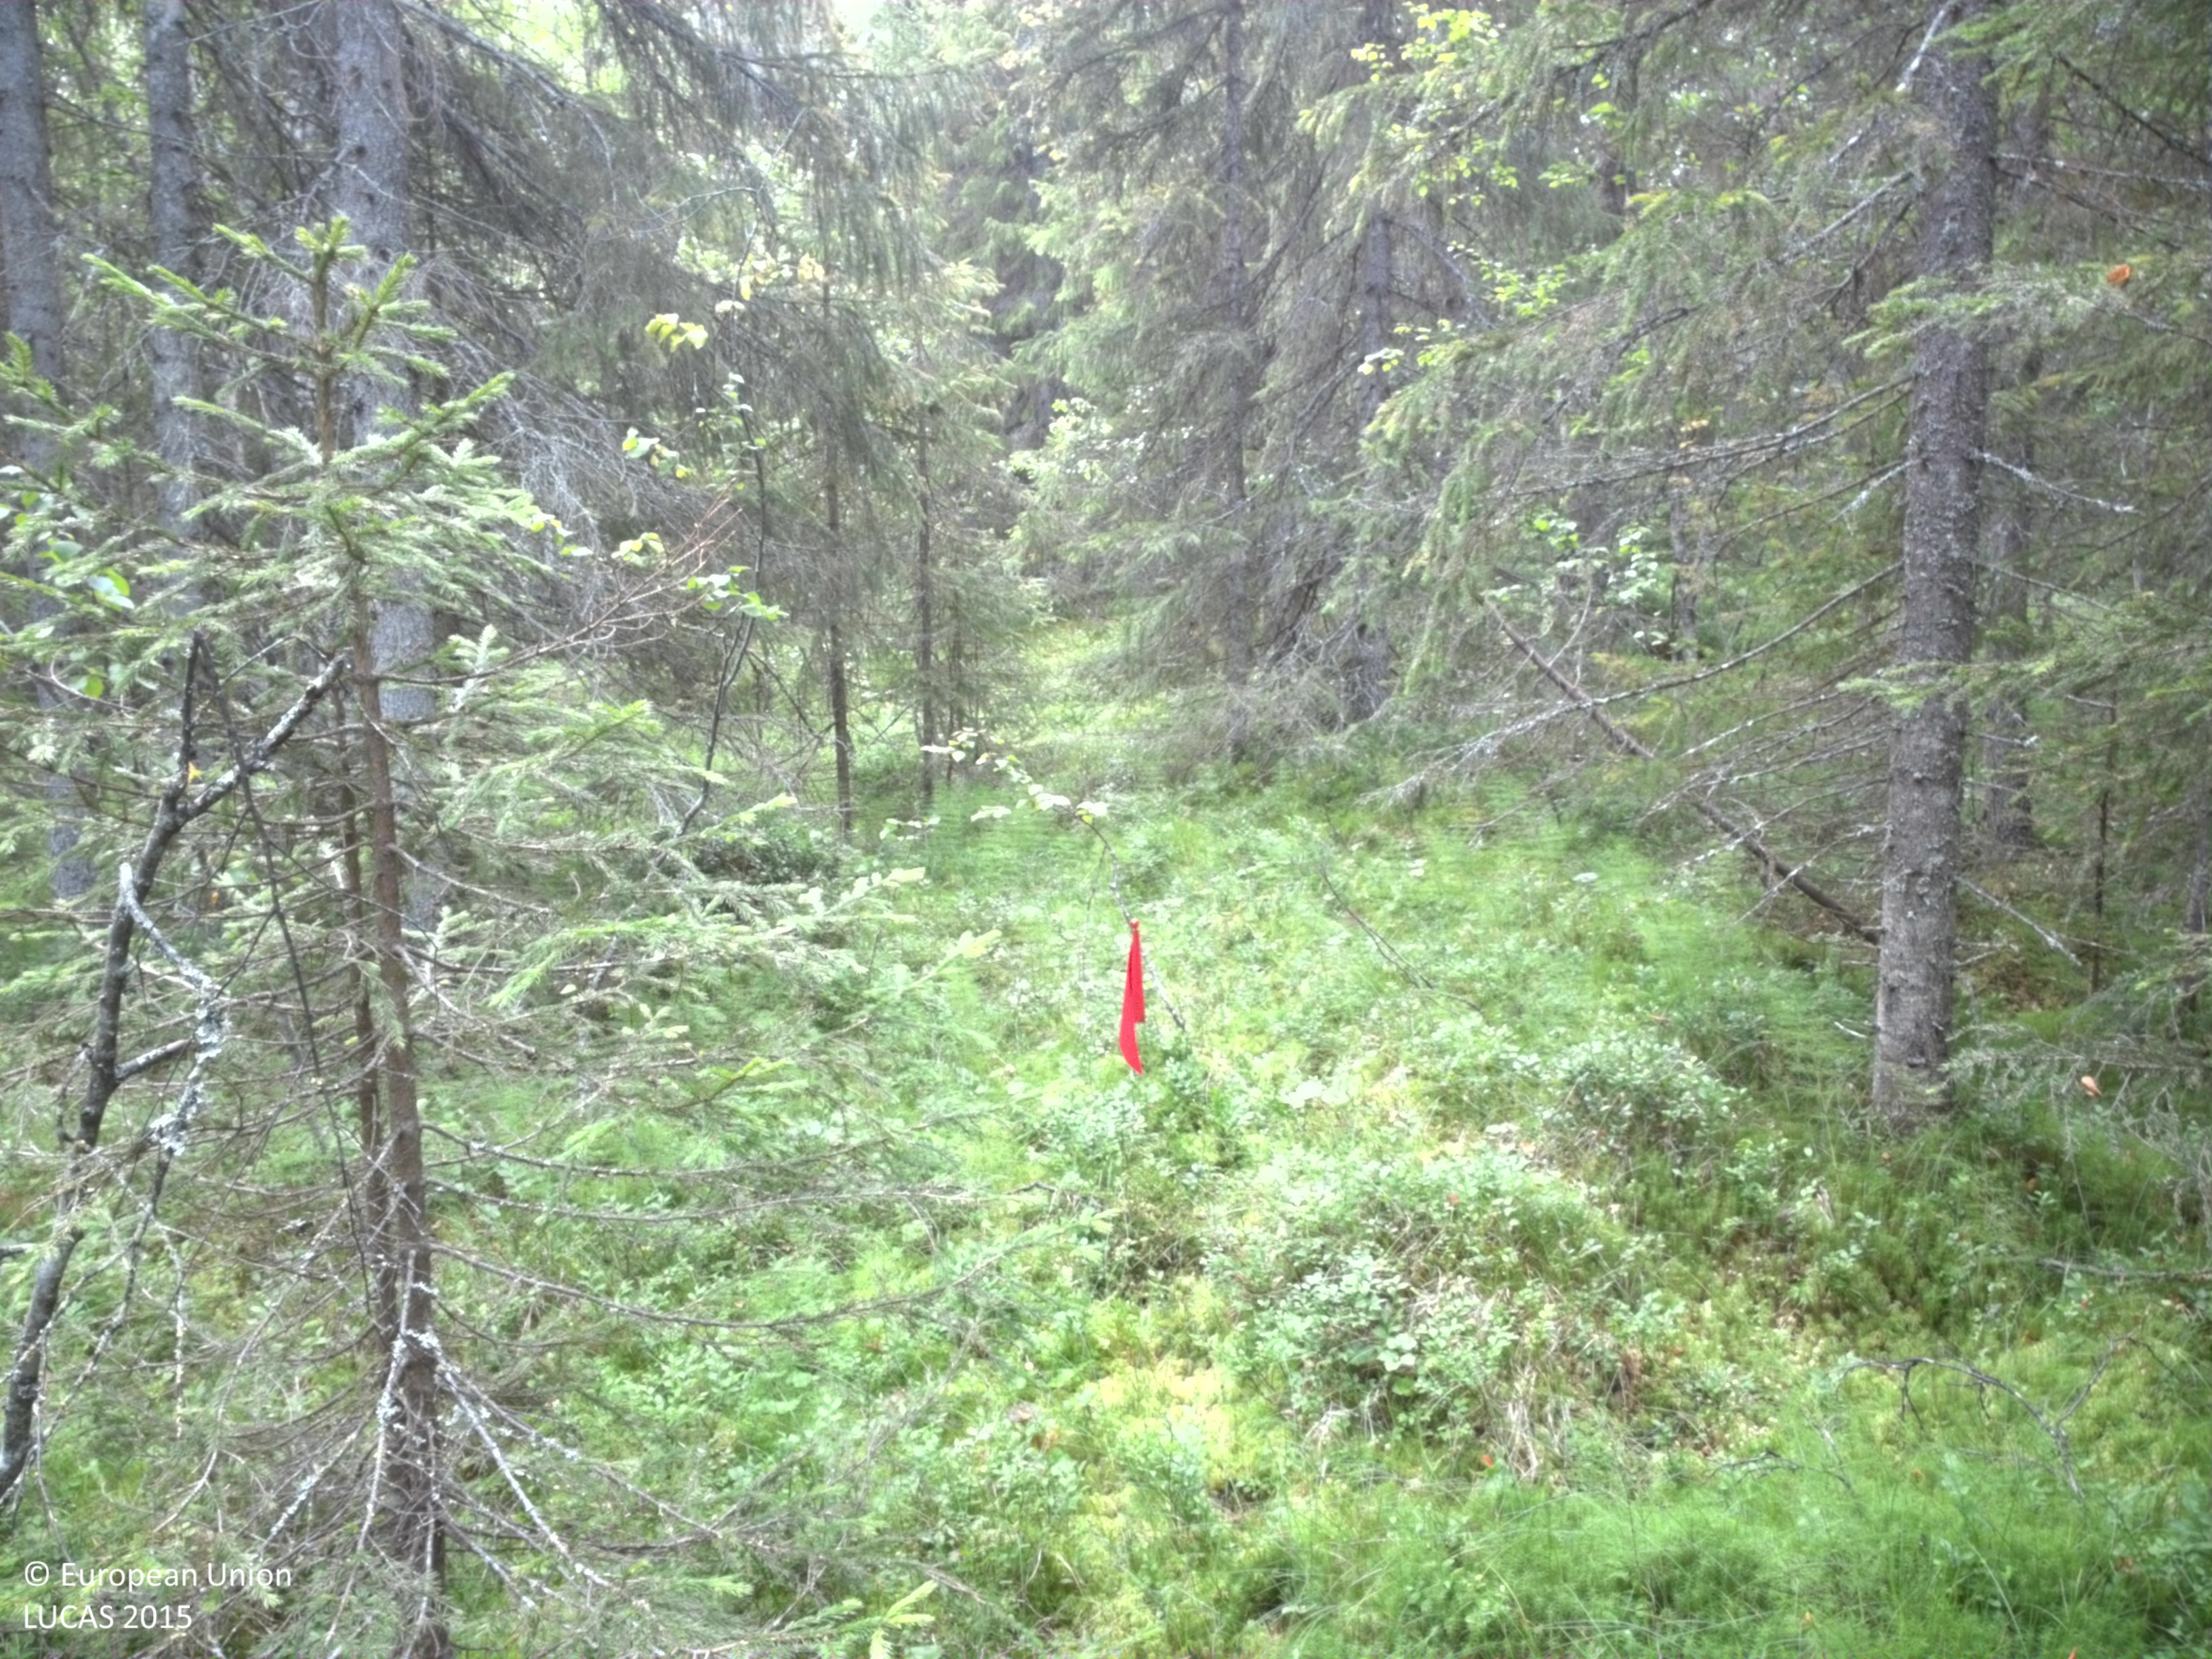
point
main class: Woodland
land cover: Spruce dominated coniferous woodland
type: boreal forest
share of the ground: 50 - 75 %
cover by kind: coniferous forest trees 60 %, shrubs 15 %, herbaceous plants 10 %, lichens and mosses 10 %, broadleaved forest trees 5 %
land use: Forestry
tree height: > 5 m
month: August
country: SE
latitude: 64.5450
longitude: 20.1717
